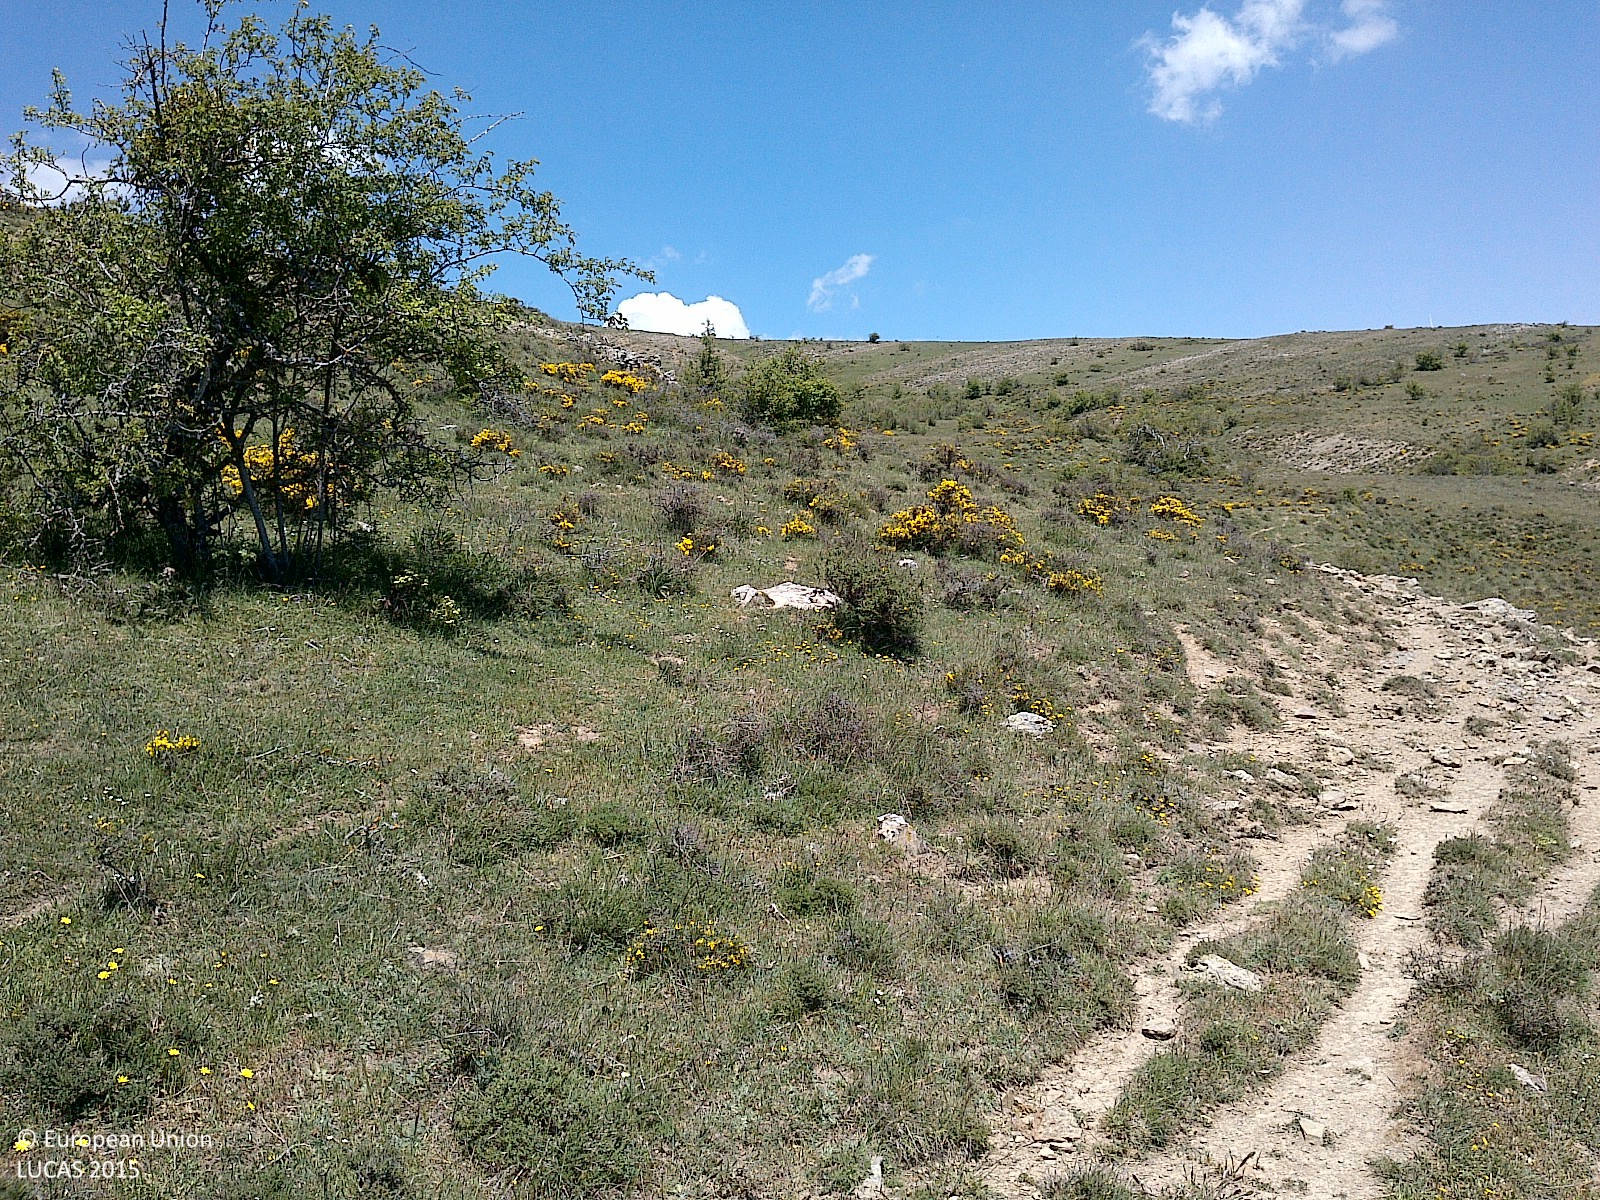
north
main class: Grassland
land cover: Grassland without tree/shrub cover
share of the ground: > 75 %
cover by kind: herbaceous plants 85 %, consolidated bare surface 10 %, shrubs 5 %
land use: Agriculture (excluding fallow land and kitchen gardens)
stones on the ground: < 10 %
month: May
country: ES
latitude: 41.9699
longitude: -2.3350
